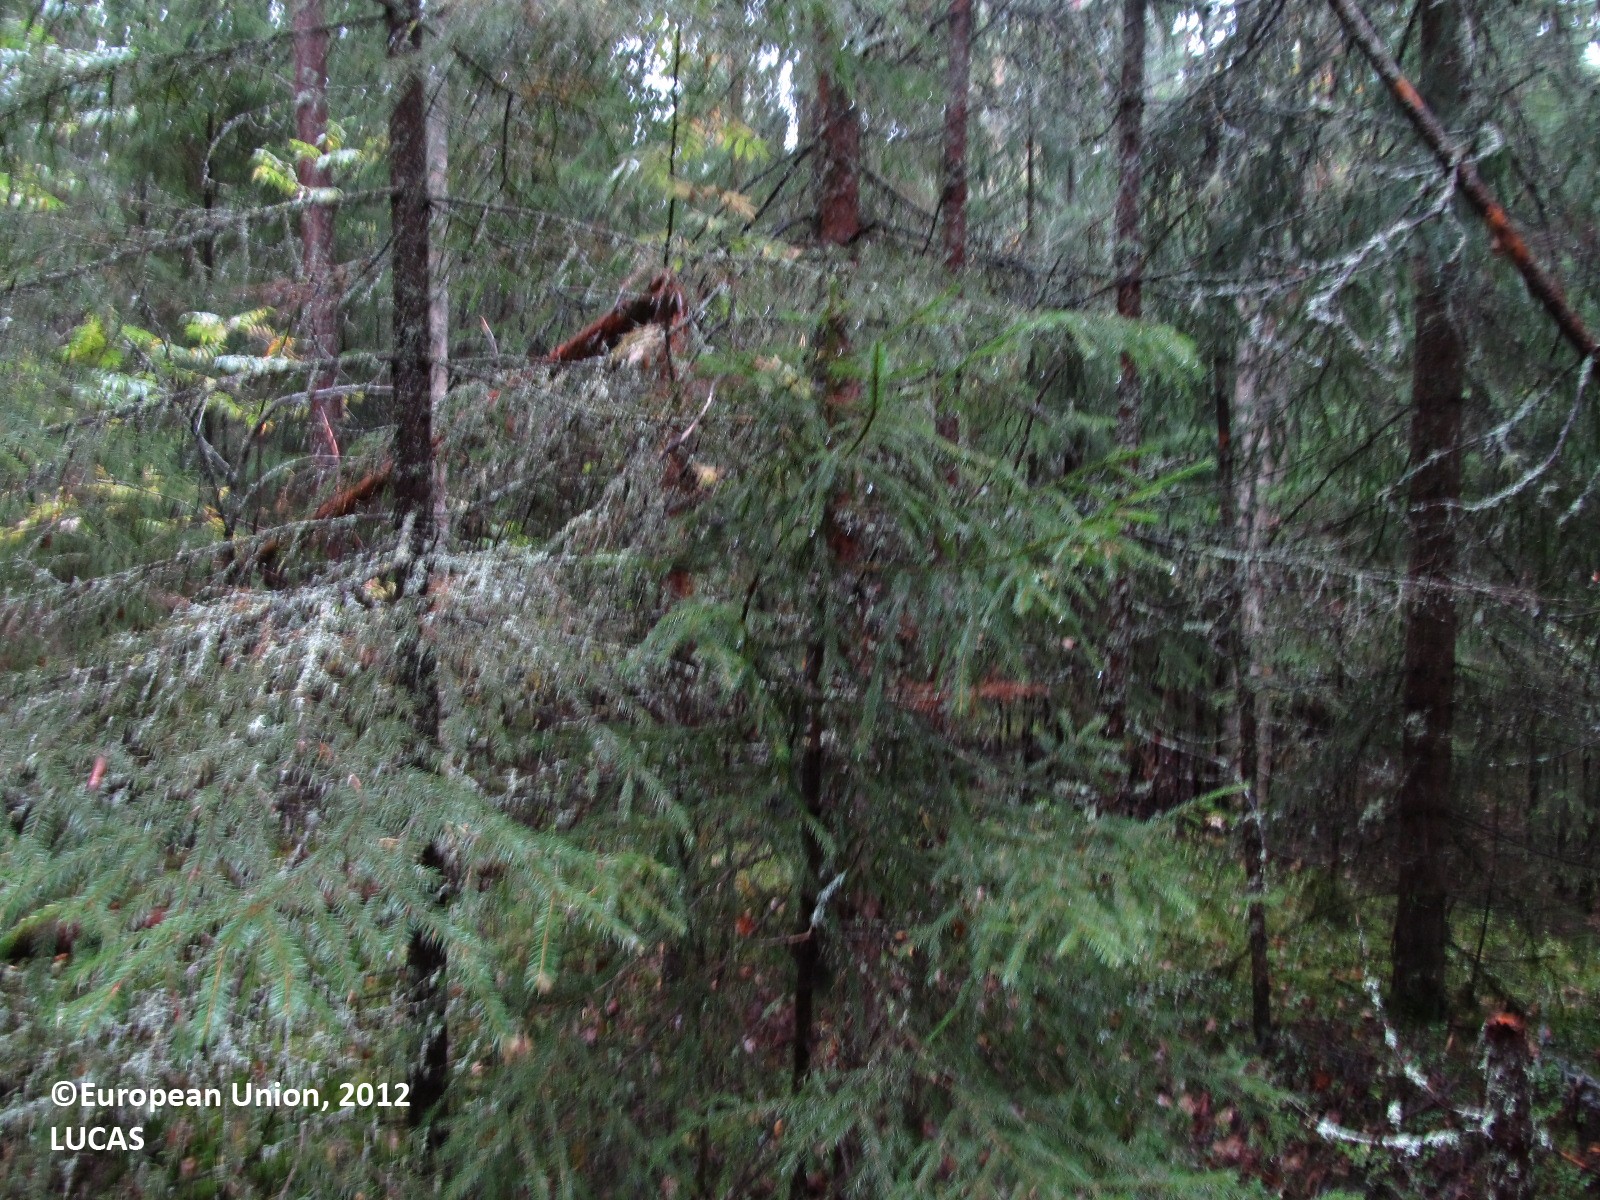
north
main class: Woodland
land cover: Spruce dominated coniferous woodland
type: boreal forest
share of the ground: 50 - 75 %
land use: Forestry
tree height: > 5 m
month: September
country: FI
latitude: 63.1997
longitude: 28.0490
